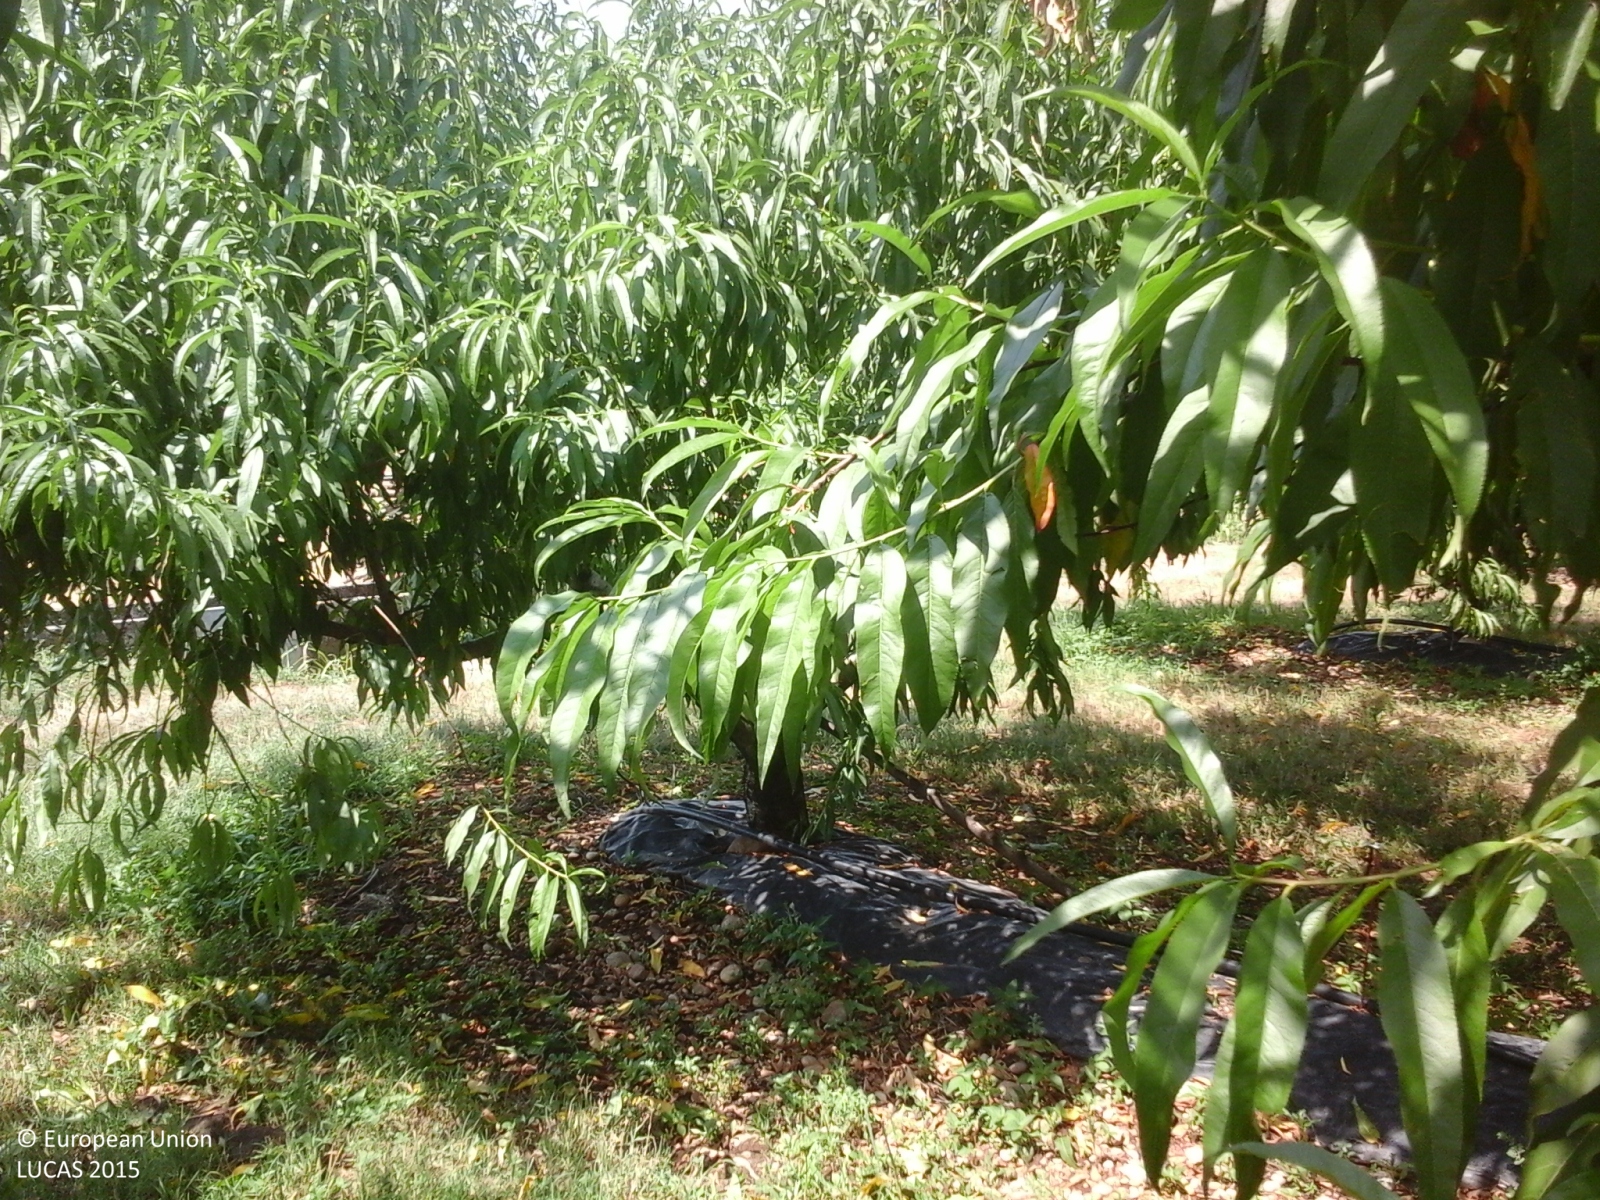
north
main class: Cropland
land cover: Other fruit trees and berries
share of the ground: > 75 %
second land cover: Grassland without tree/shrub cover
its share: > 75 %
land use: Agriculture (excluding fallow land and kitchen gardens)
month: July
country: IT
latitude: 45.2854
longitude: 10.7508
